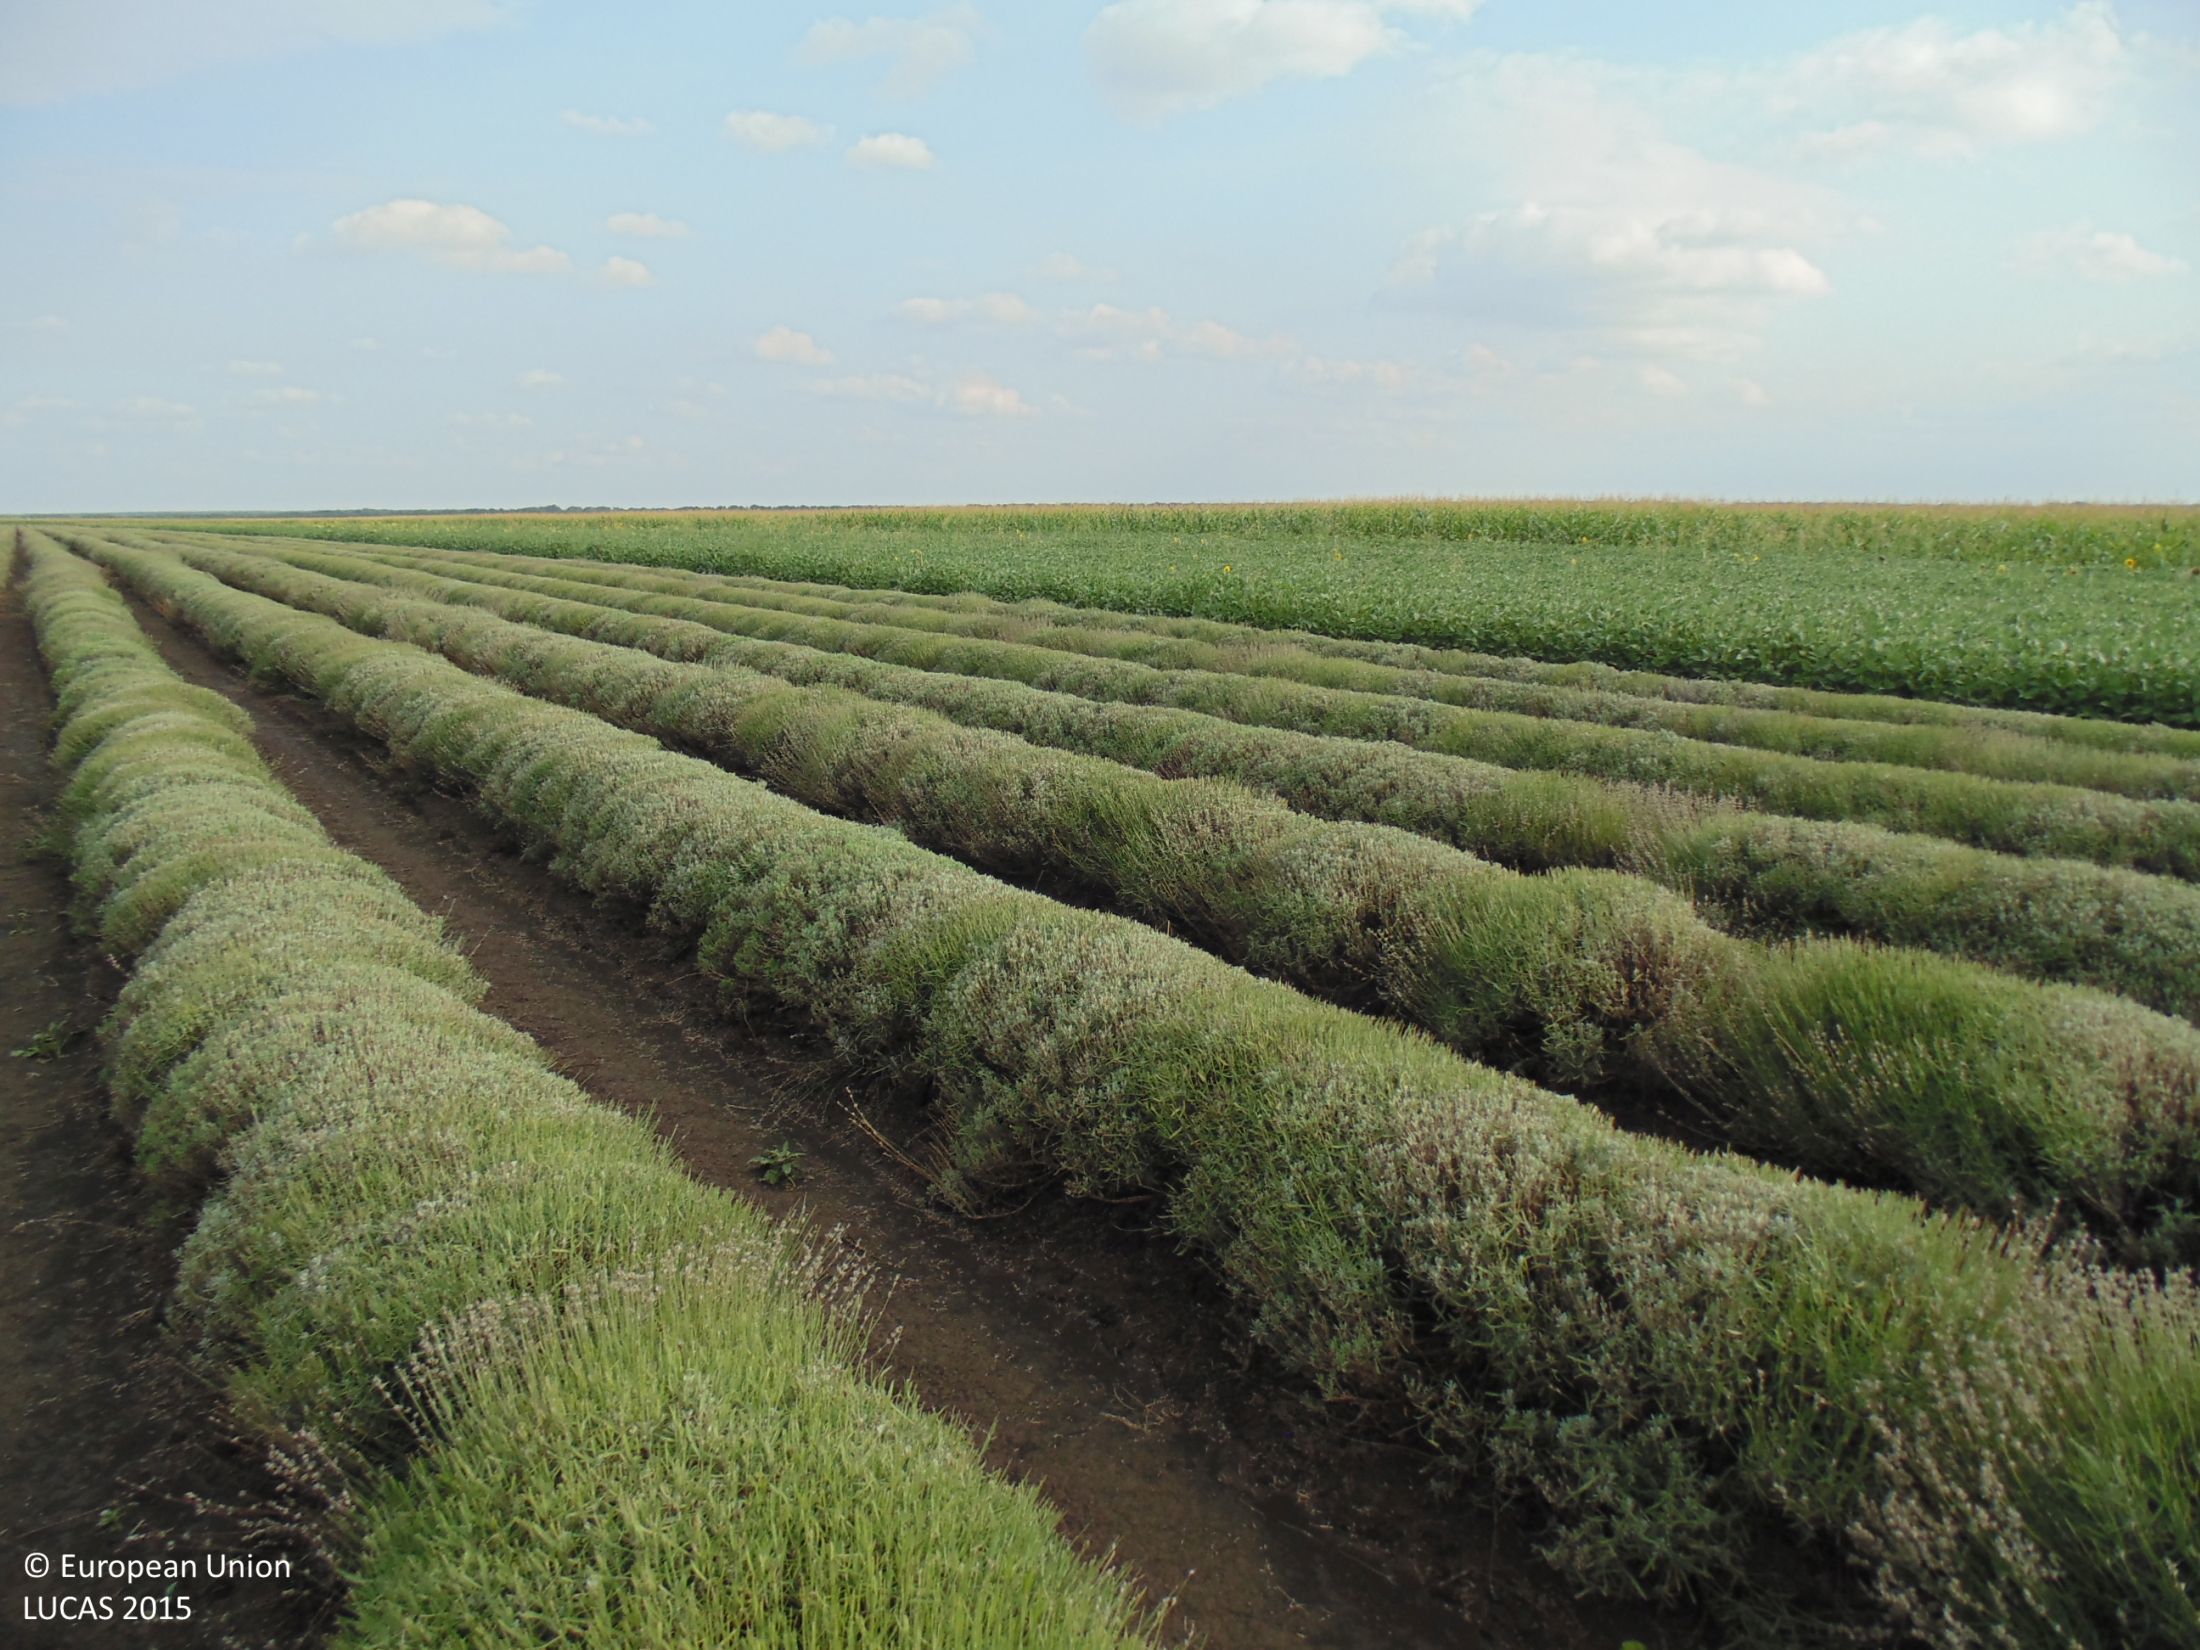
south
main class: Cropland
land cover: Other non-permanent industrial crops
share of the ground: > 75 %
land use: Agriculture (excluding fallow land and kitchen gardens)
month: August
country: BG
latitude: 43.7703
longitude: 28.0266
